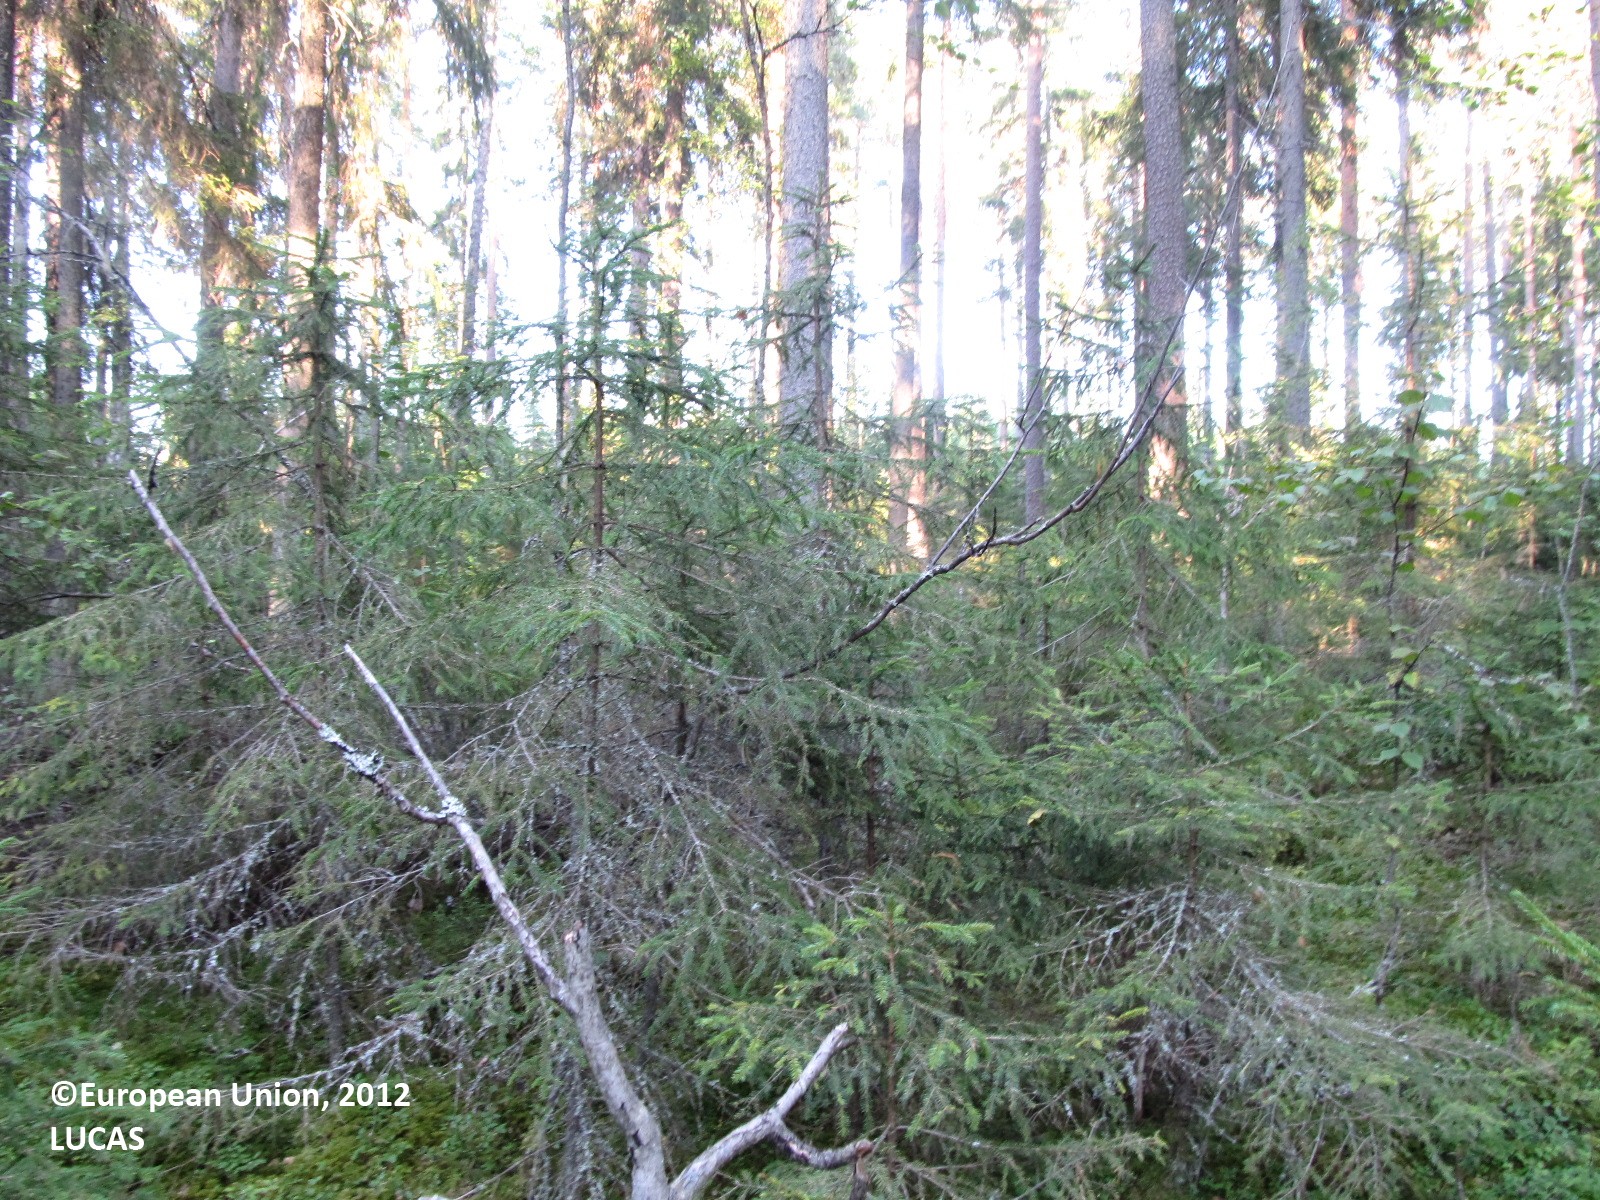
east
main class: Woodland
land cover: Other coniferous woodland
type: boreal forest
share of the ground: 50 - 75 %
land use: Forestry
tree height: > 5 m
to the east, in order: Other coniferous woodland; Pine dominated mixed woodland; Ditches and canals; Grass margins; Paved roads, cycling and walking lanes; Grass margins; Ditches and canals; Pine dominated mixed woodland; Broadleaved woodland; Ditches and canals; Broadleaved woodland; Spruce dominated coniferous woodland; Ditches and canals; Spruce dominated coniferous woodland
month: August
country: FI
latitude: 62.1057
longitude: 27.7098
